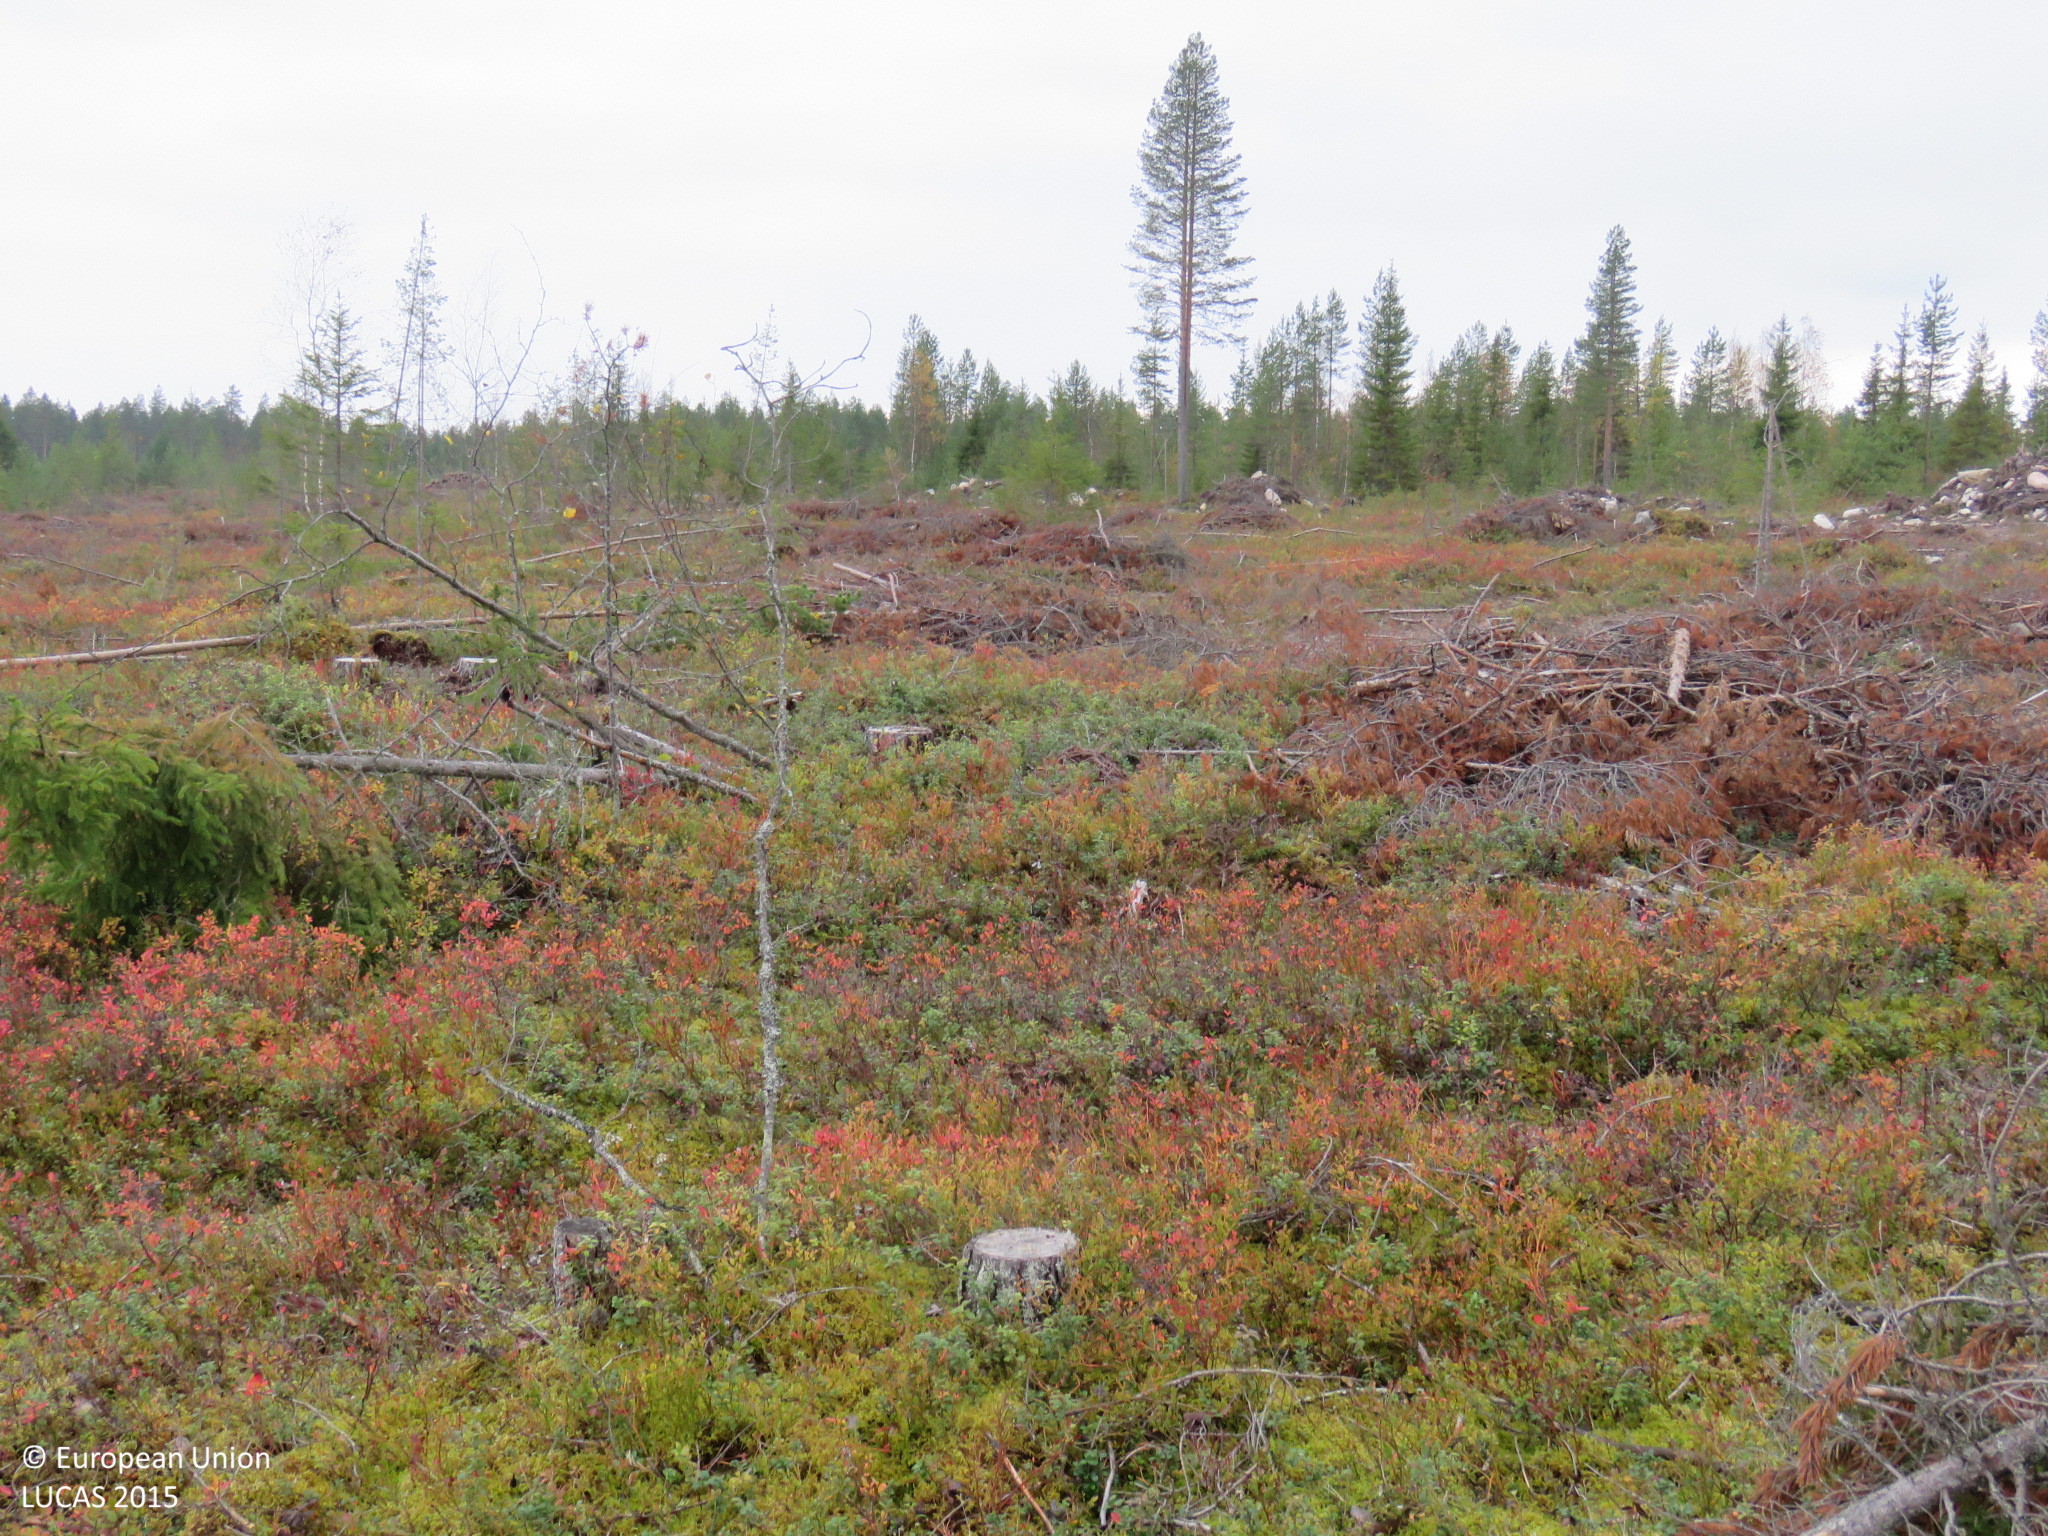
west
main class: Shrubland
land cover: Shrubland with sparse tree cover
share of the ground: 50 - 75 %
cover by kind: shrubs 55 %, lichens and mosses 30 %, coniferous forest trees 5 %, unconsolidated bare surface 5 %
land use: Forestry
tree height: < 5 m
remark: Clear cut
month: September
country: FI
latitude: 65.2923
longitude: 26.6389
